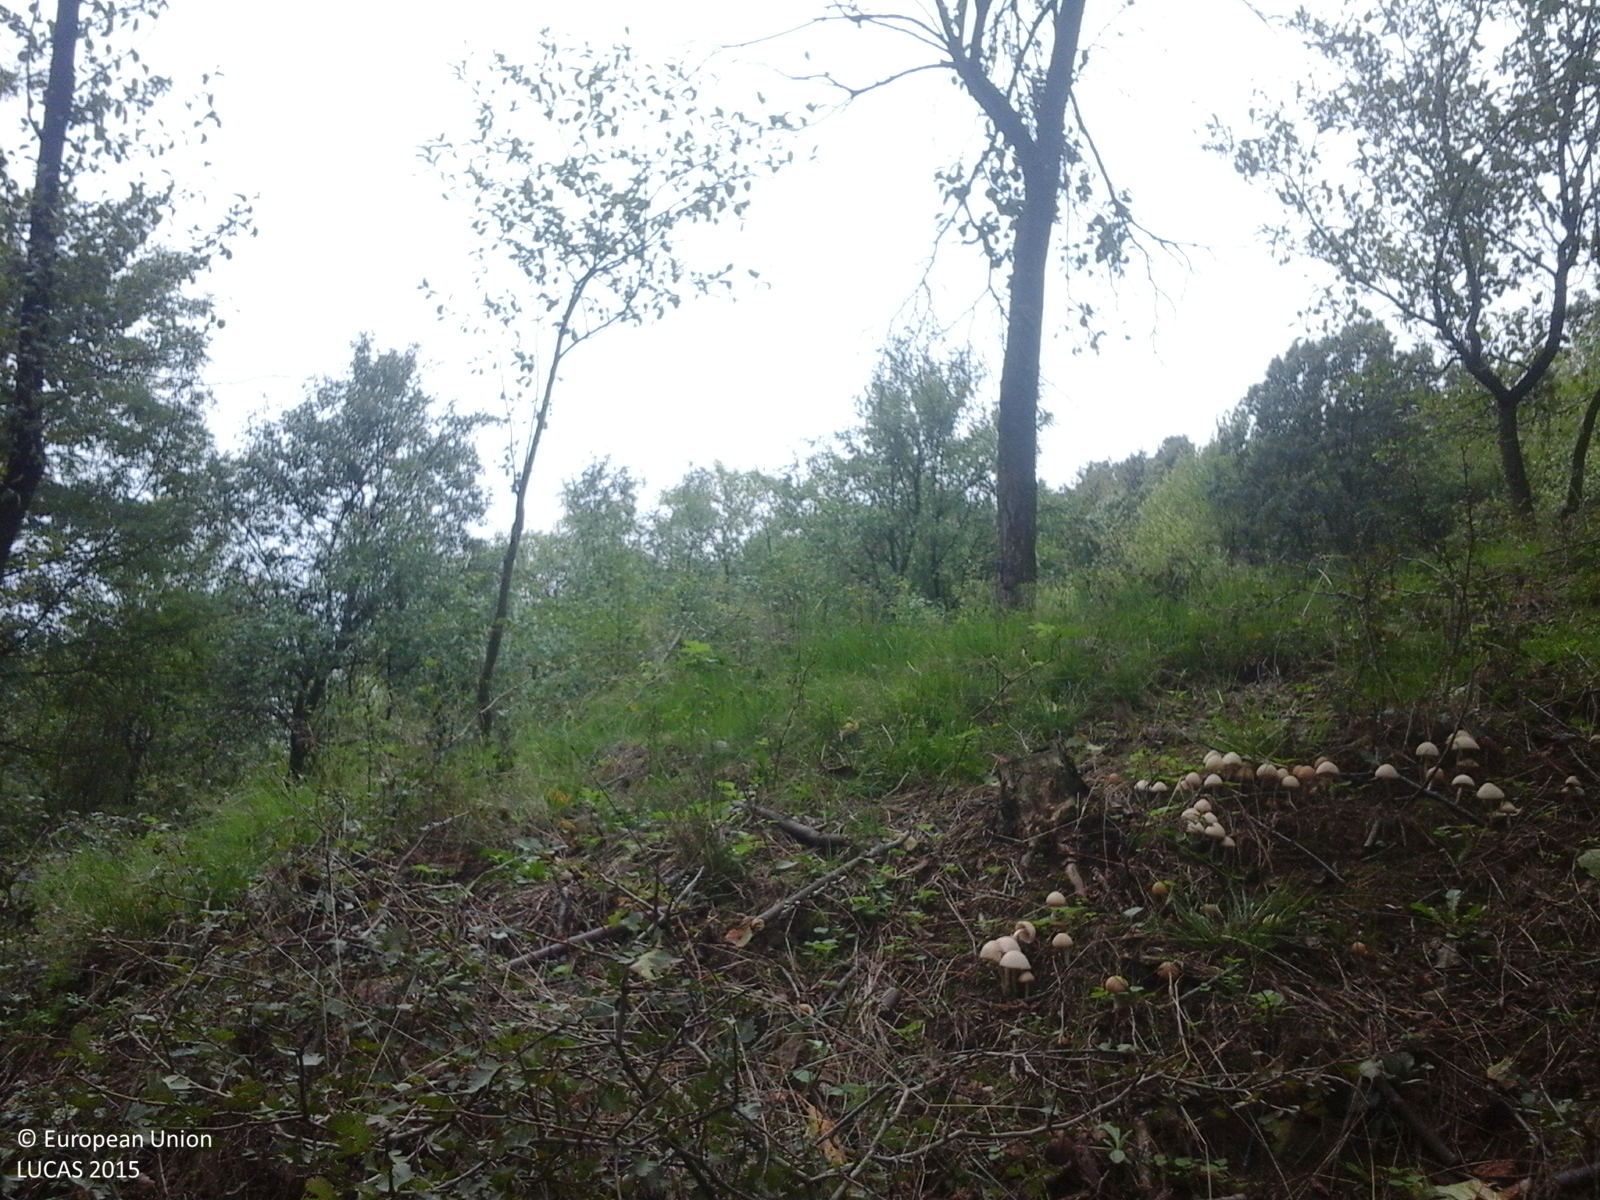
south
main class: Woodland
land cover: Broadleaved woodland
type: exotic forest
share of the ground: > 75 %
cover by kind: broadleaved forest trees 100 %
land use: Forestry
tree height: > 5 m
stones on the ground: < 10 %
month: September
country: RO
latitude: 45.8752
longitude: 23.0557
